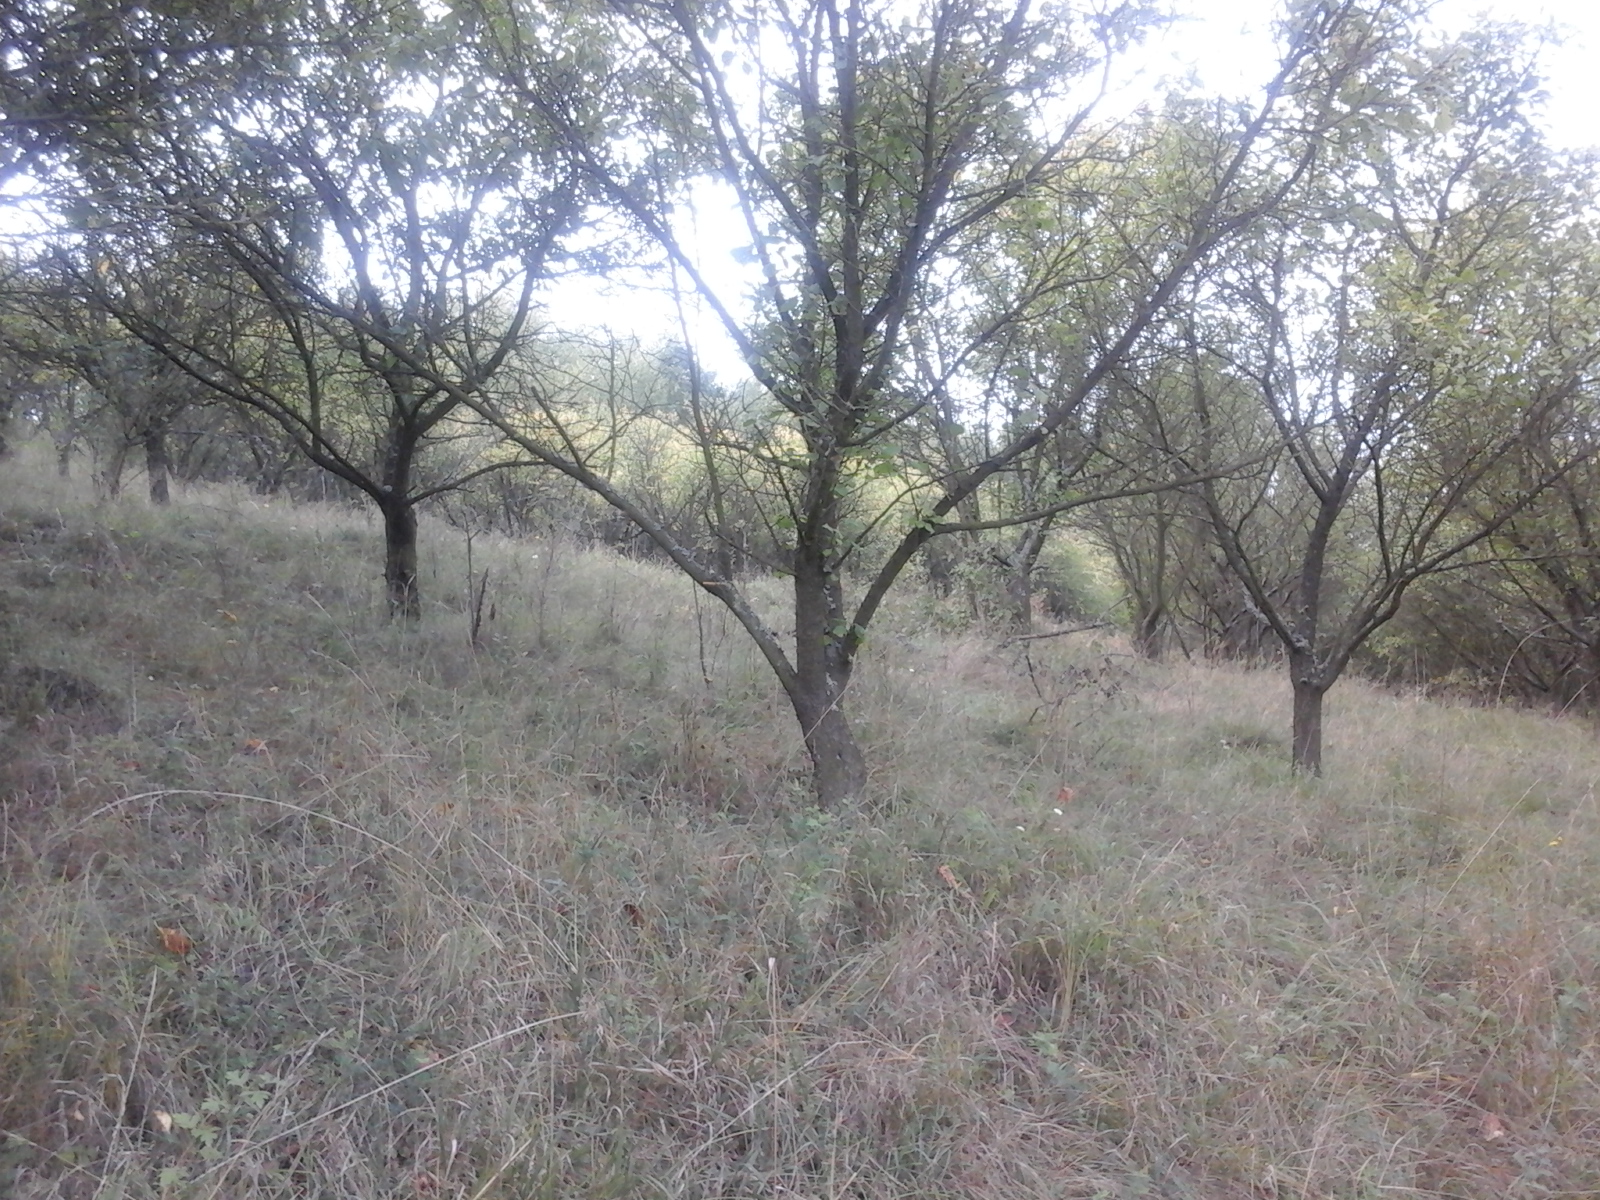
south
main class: Cropland
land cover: Other fruit trees and berries
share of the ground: > 75 %
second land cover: Grassland without tree/shrub cover
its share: > 75 %
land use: Agriculture (excluding fallow land and kitchen gardens)
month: September
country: RO
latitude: 45.7222
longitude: 22.9663
